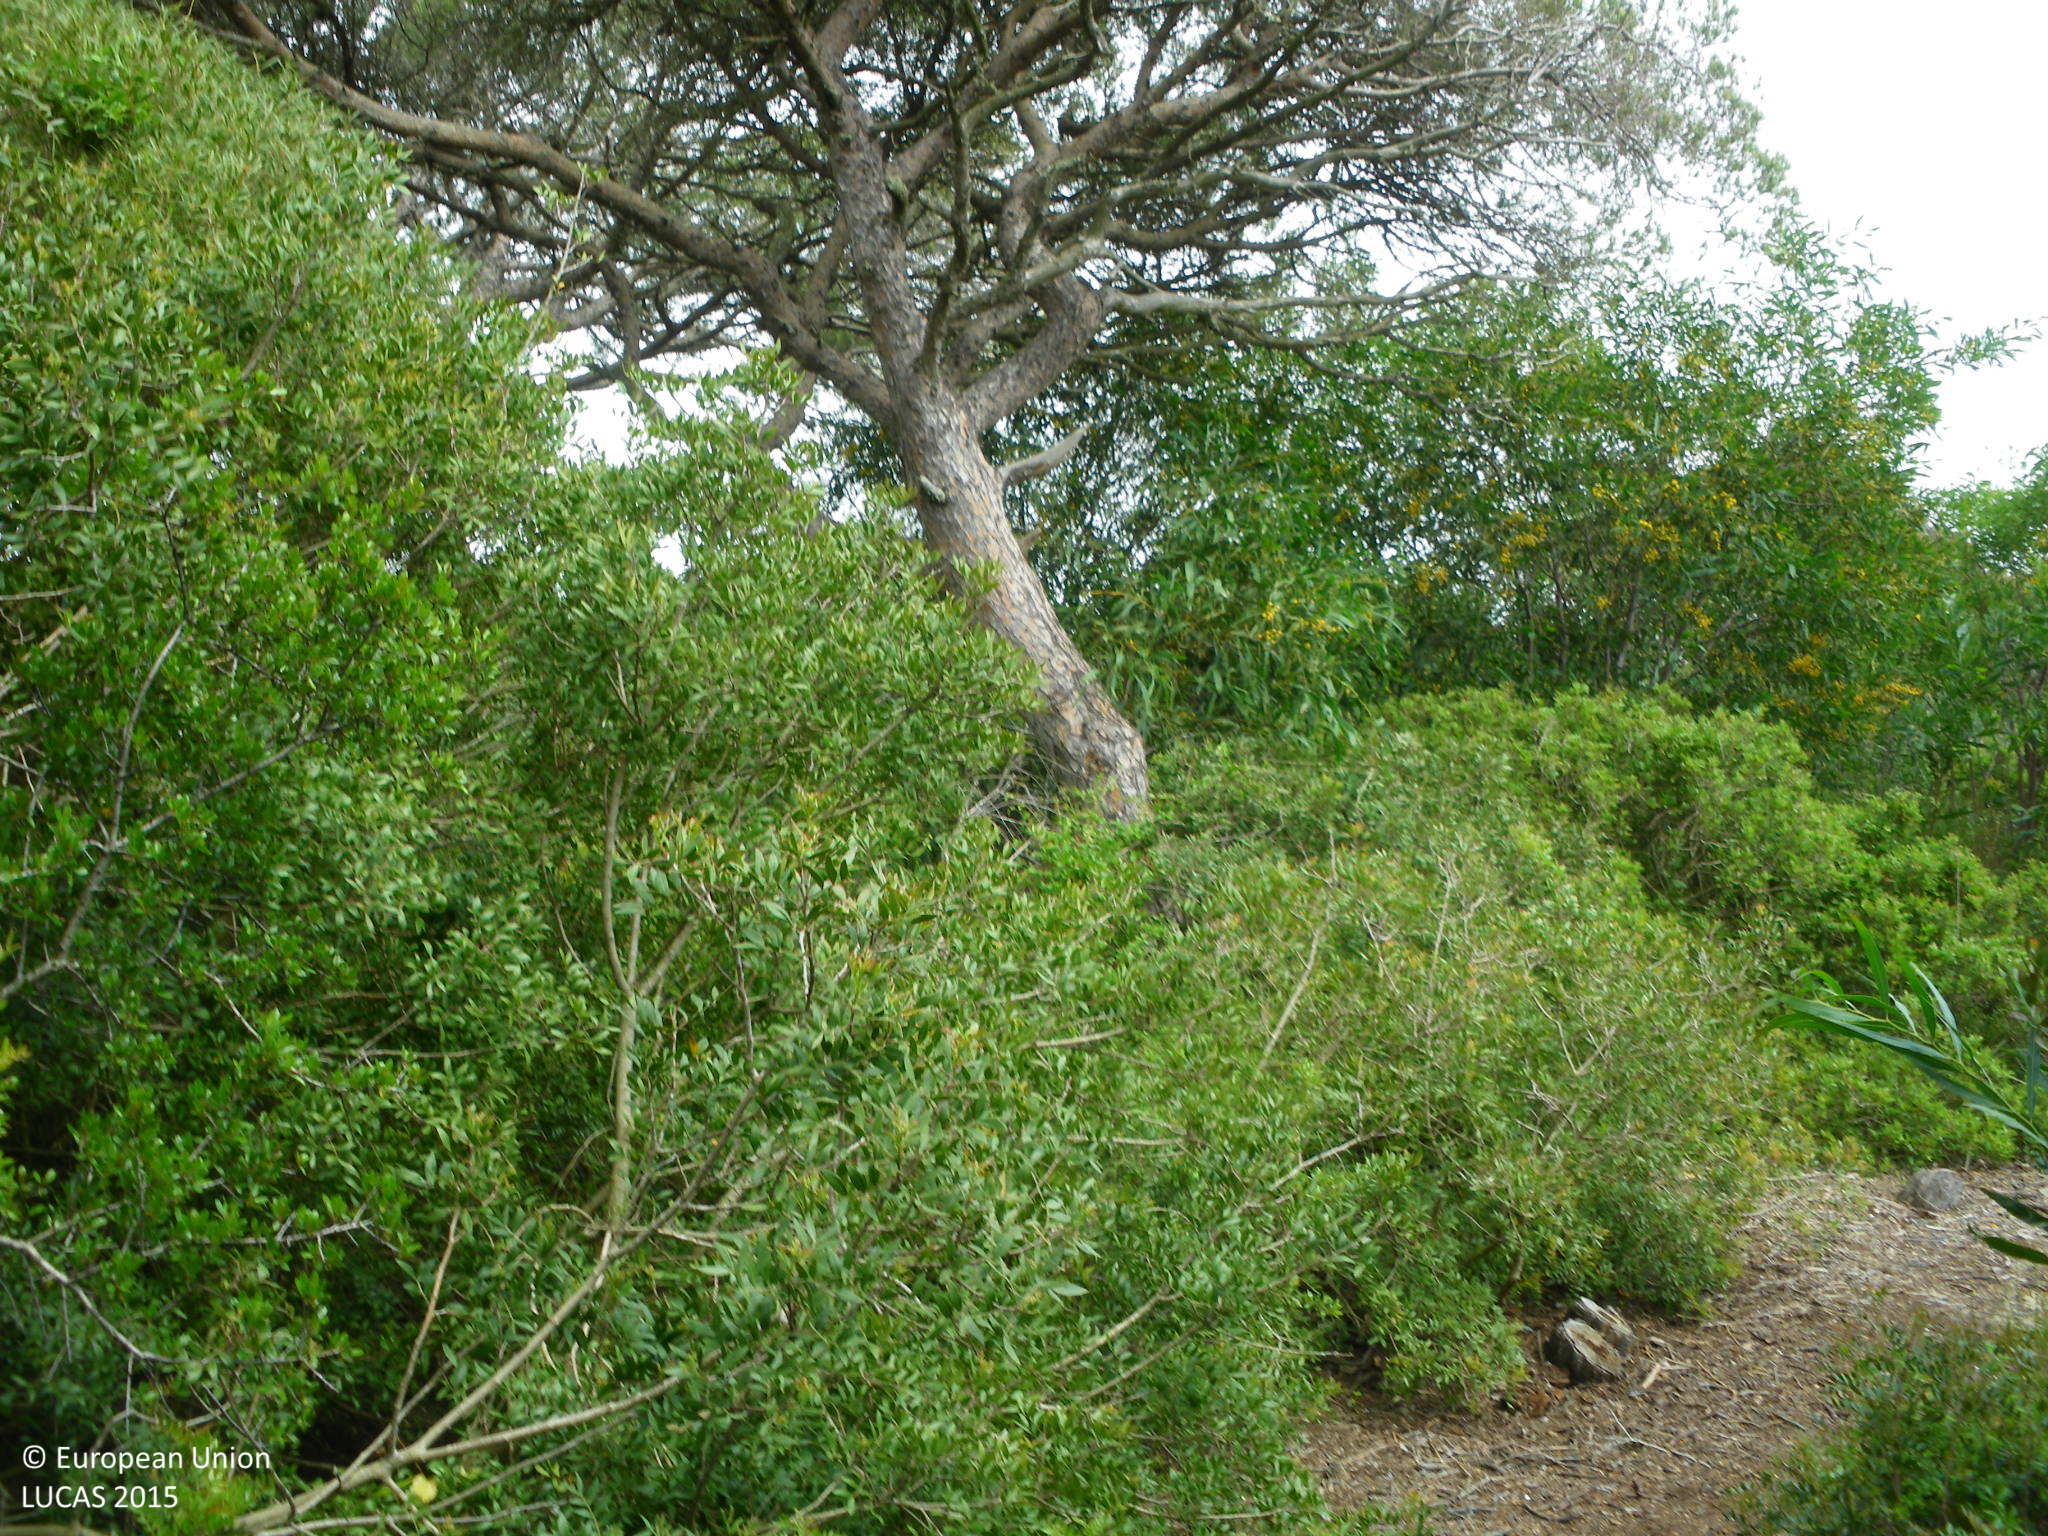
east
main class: Woodland
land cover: Pine dominated coniferous woodland
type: coniferous forest of the mediterranean region
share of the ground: 50 - 75 %
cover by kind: coniferous forest trees 55 %, shrubs 35 %, herbaceous plants 5 %, unconsolidated bare surface 5 %
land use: Forestry
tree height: > 5 m
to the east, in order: Pine dominated coniferous woodland; Tracks; Pine dominated coniferous woodland; Shrubland with sparse tree cover; Tracks; Shrubland with sparse tree cover; Grassland without tree/shrub cover; Tracks; Grassland without tree/shrub cover; Fences; Paved roads, cycling and walking lanes; Artificial constructions in urban areas
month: April
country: ES
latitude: 36.3845
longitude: -6.2050
